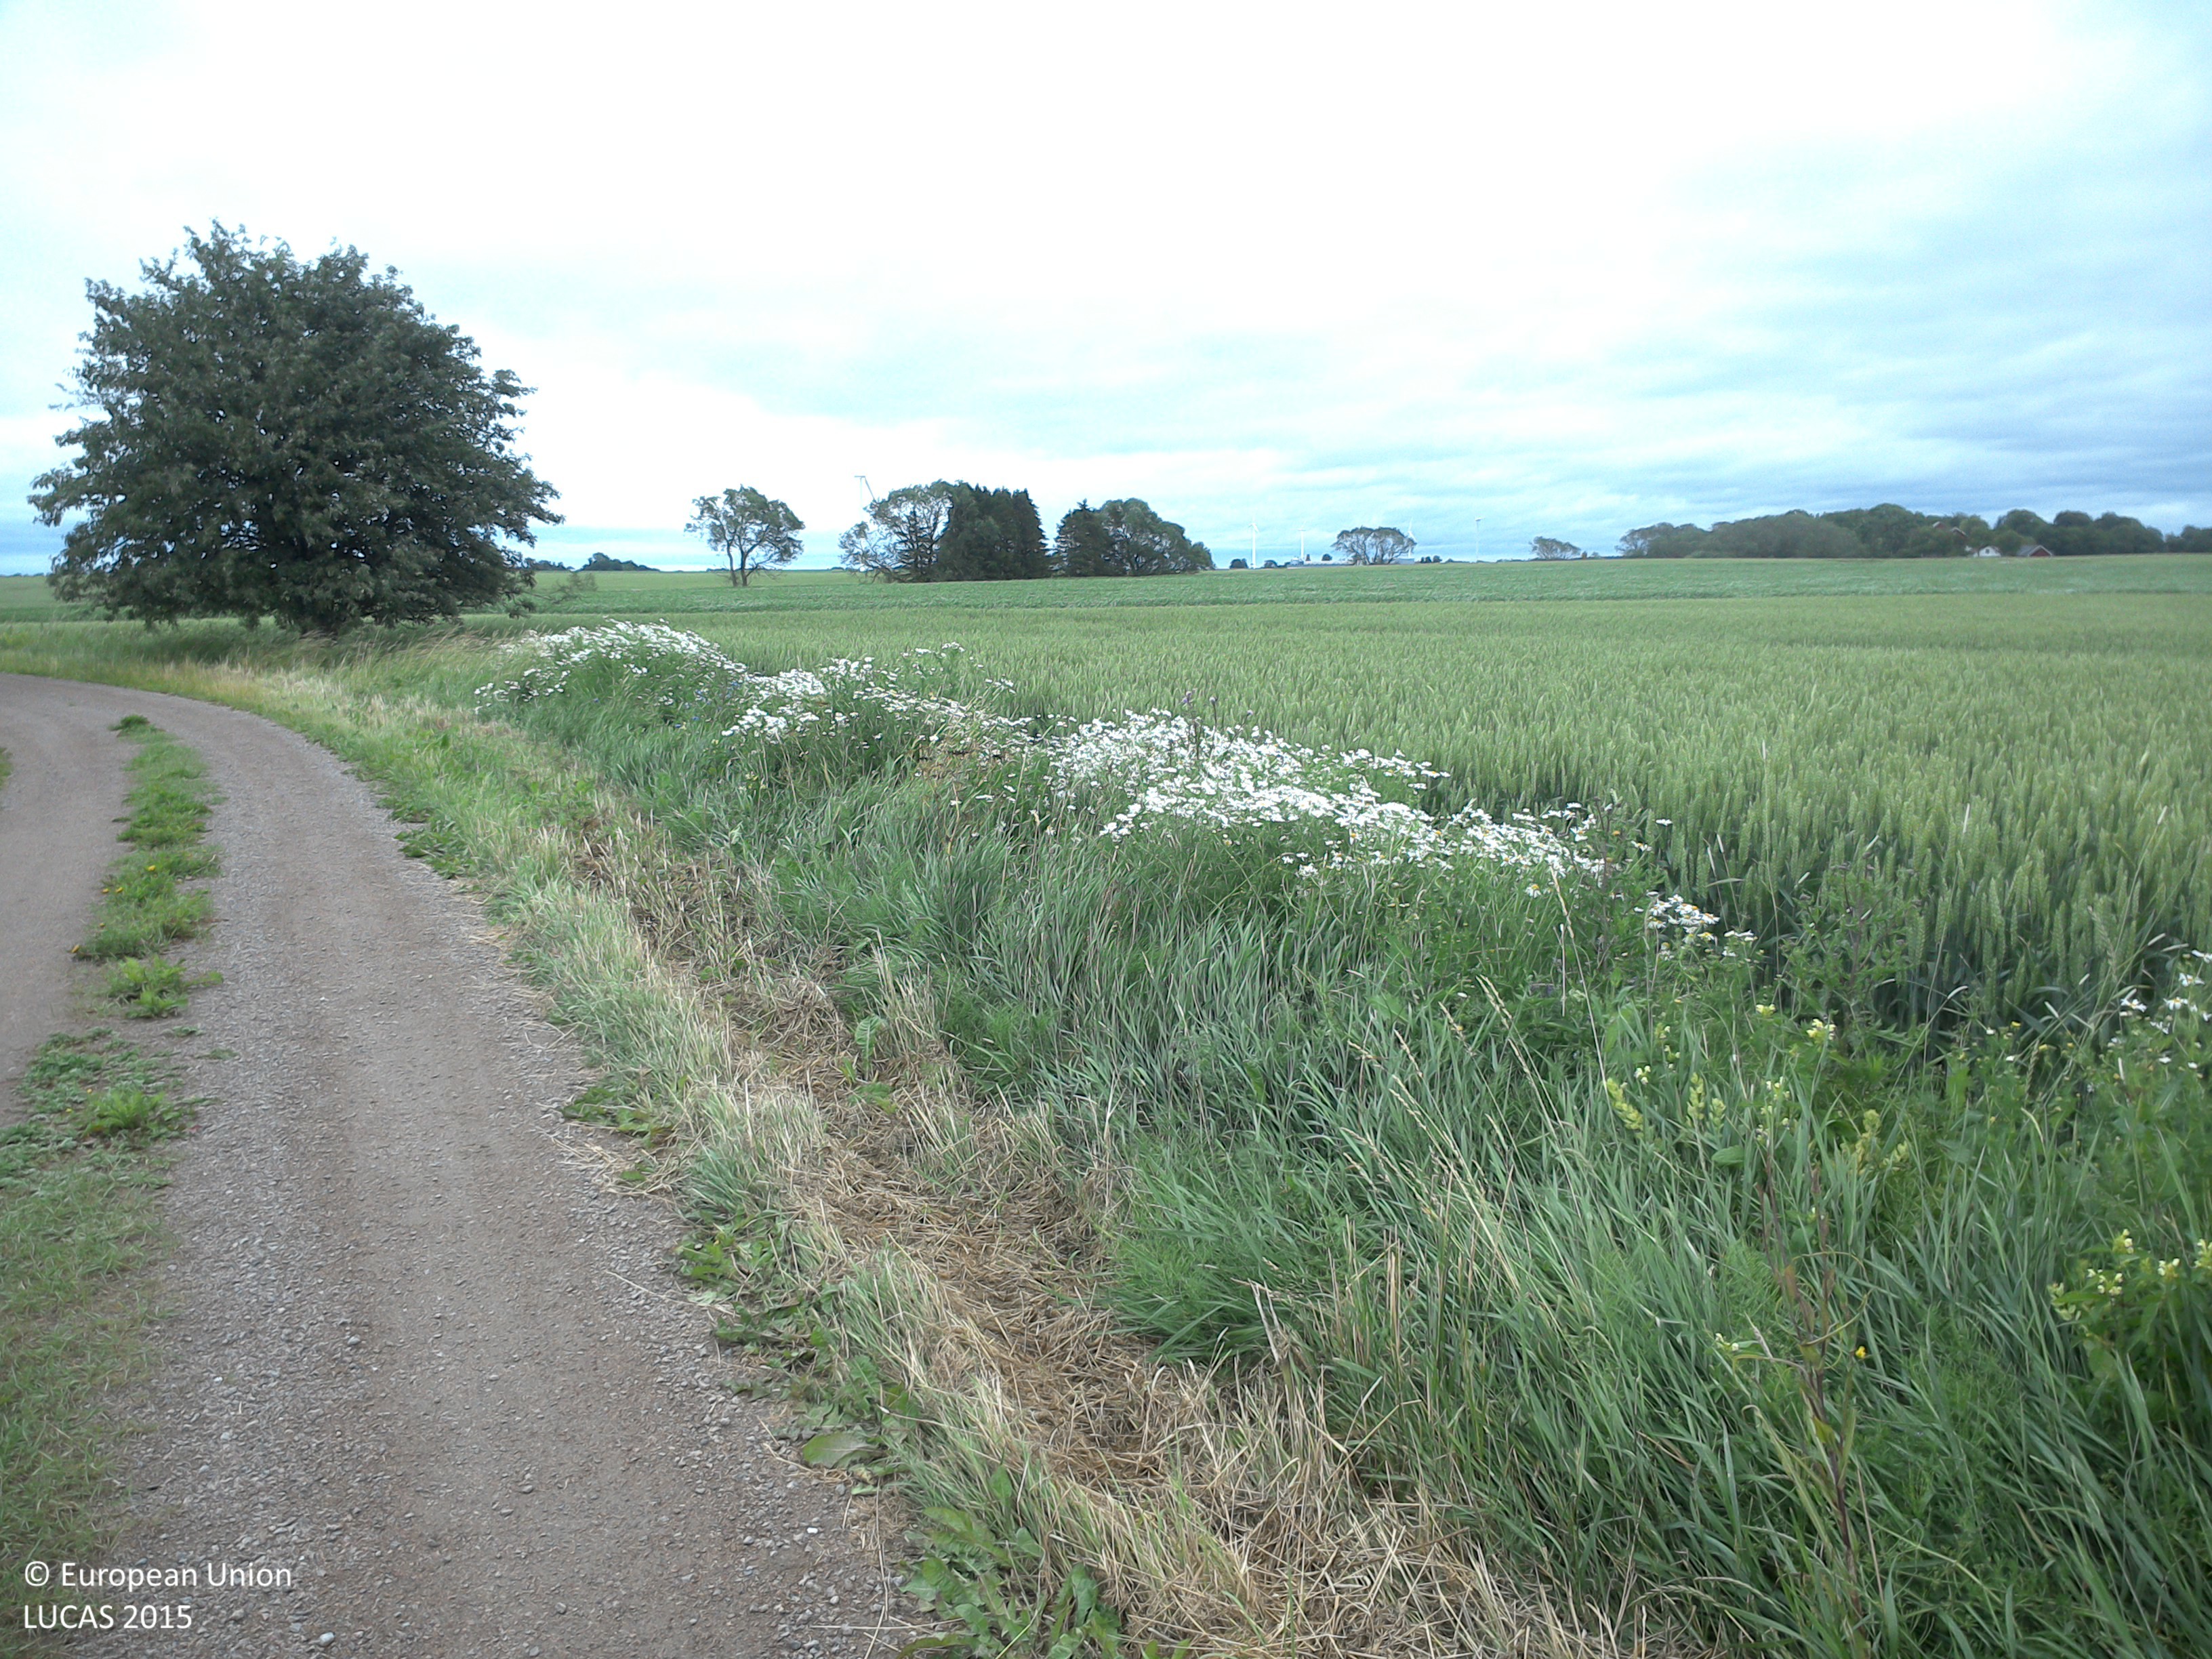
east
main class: Cropland
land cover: Dry pulses
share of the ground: > 75 %
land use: Agriculture (excluding fallow land and kitchen gardens)
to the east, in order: Dry pulses; Grass margins; Common wheat
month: July
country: SE
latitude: 58.2977
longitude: 14.7541
